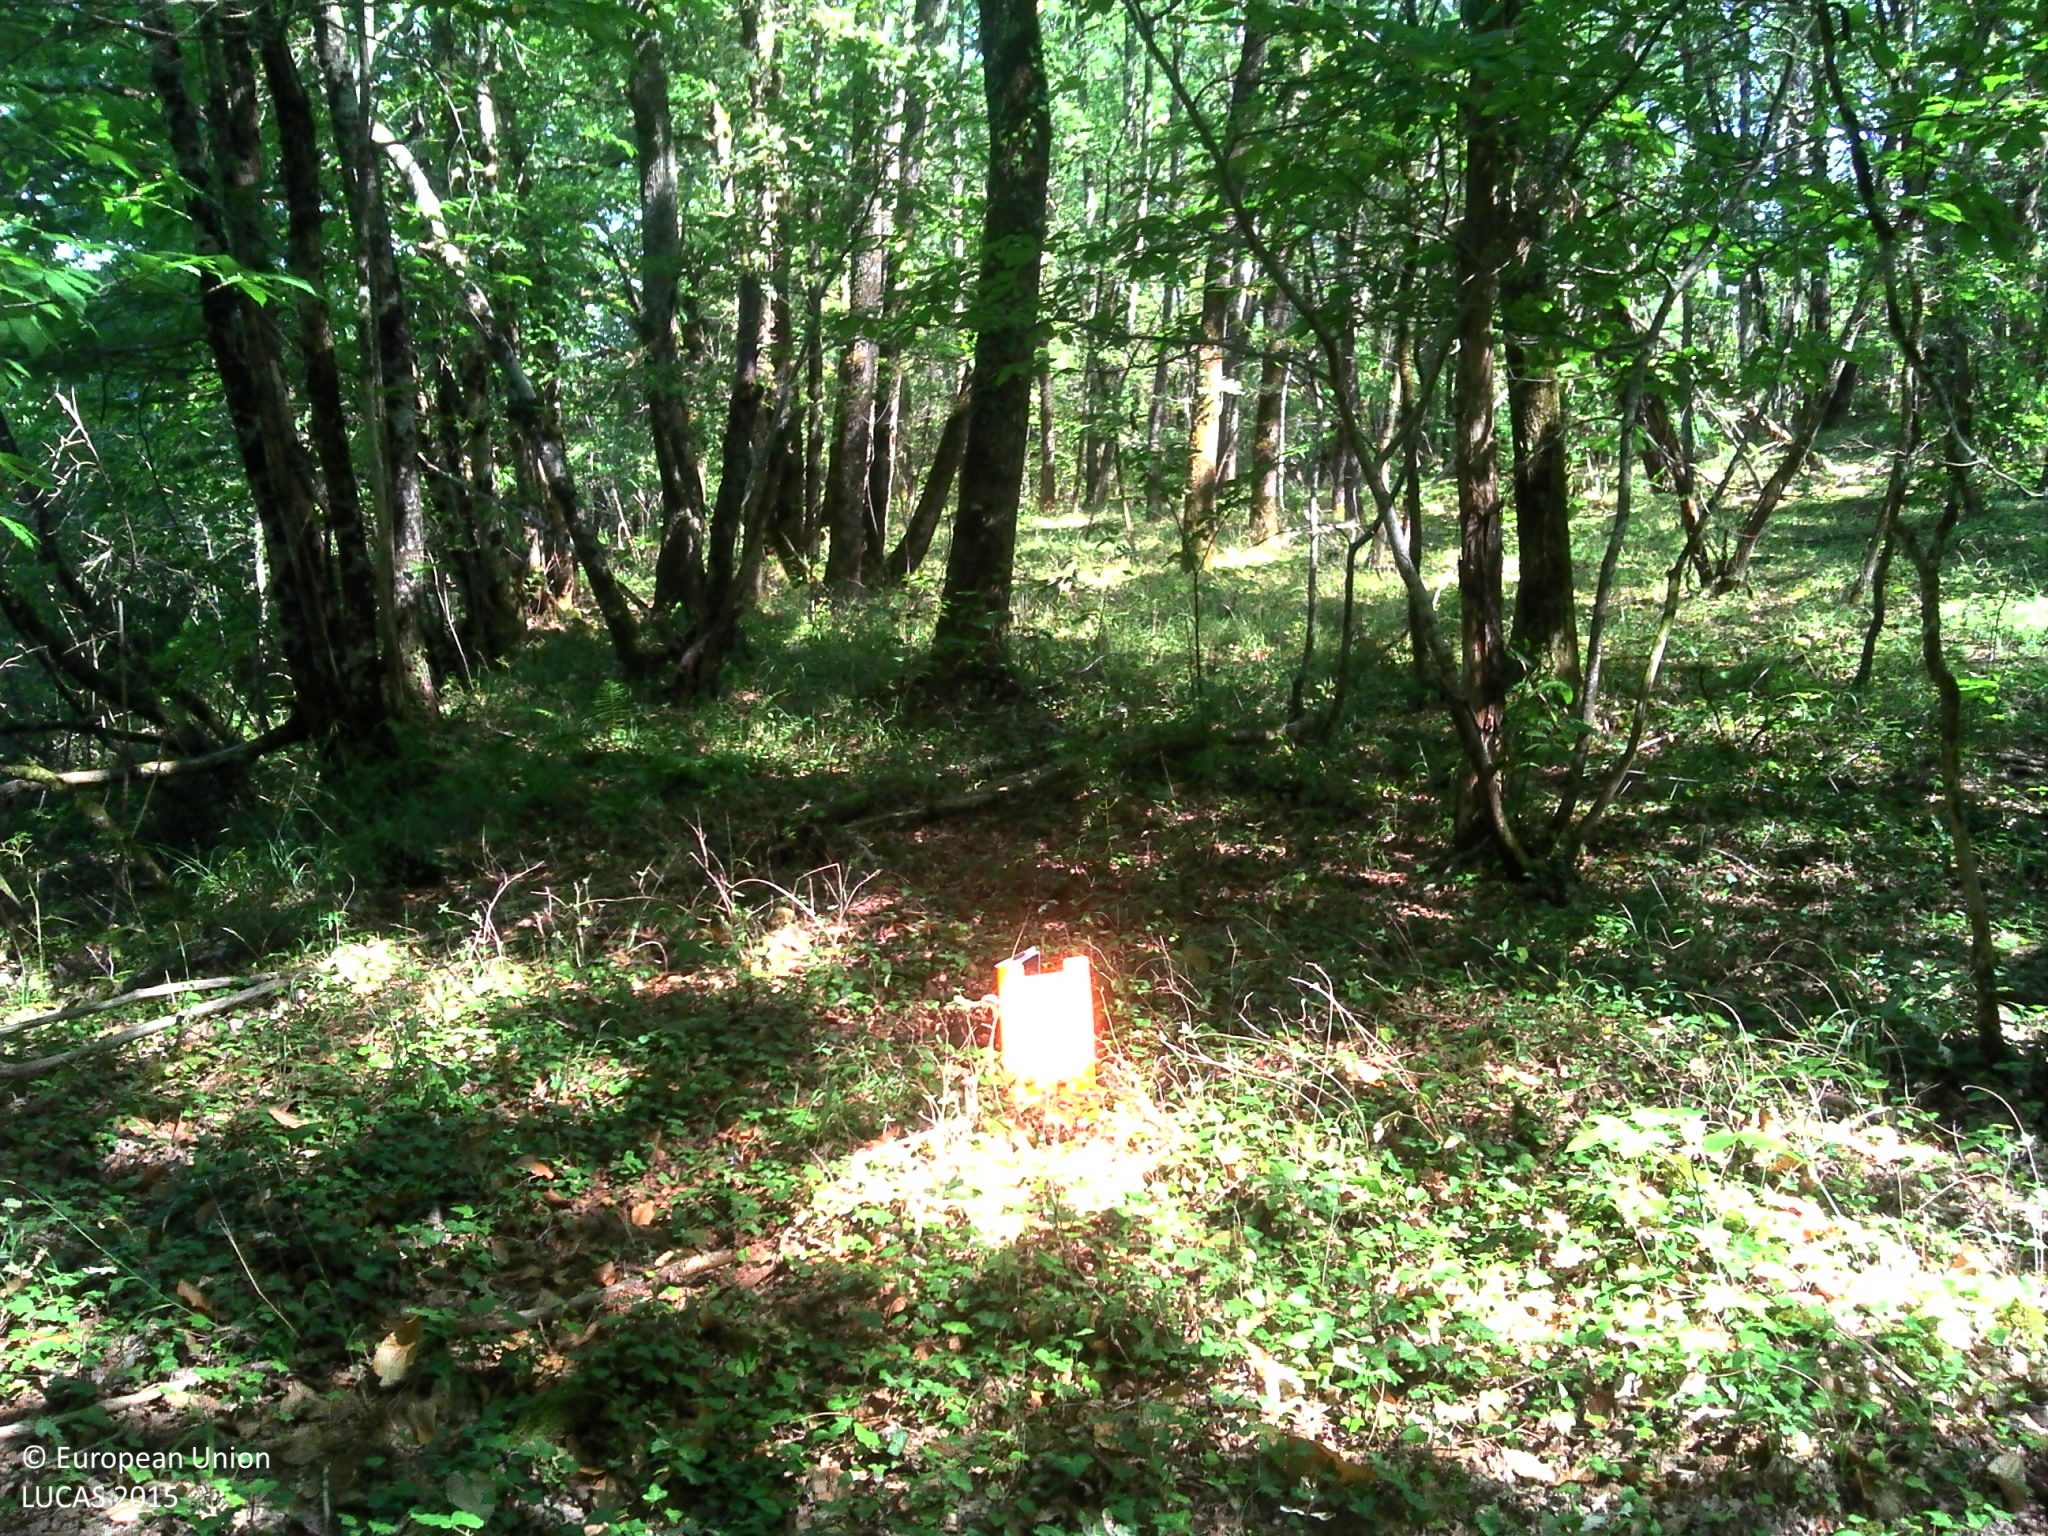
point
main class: Woodland
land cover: Broadleaved woodland
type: thermophilous deciduous forest
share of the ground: > 75 %
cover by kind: broadleaved forest trees 90 %, herbaceous plants 10 %
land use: Forestry
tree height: > 5 m
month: August
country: FR
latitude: 44.5424
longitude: 1.2493
